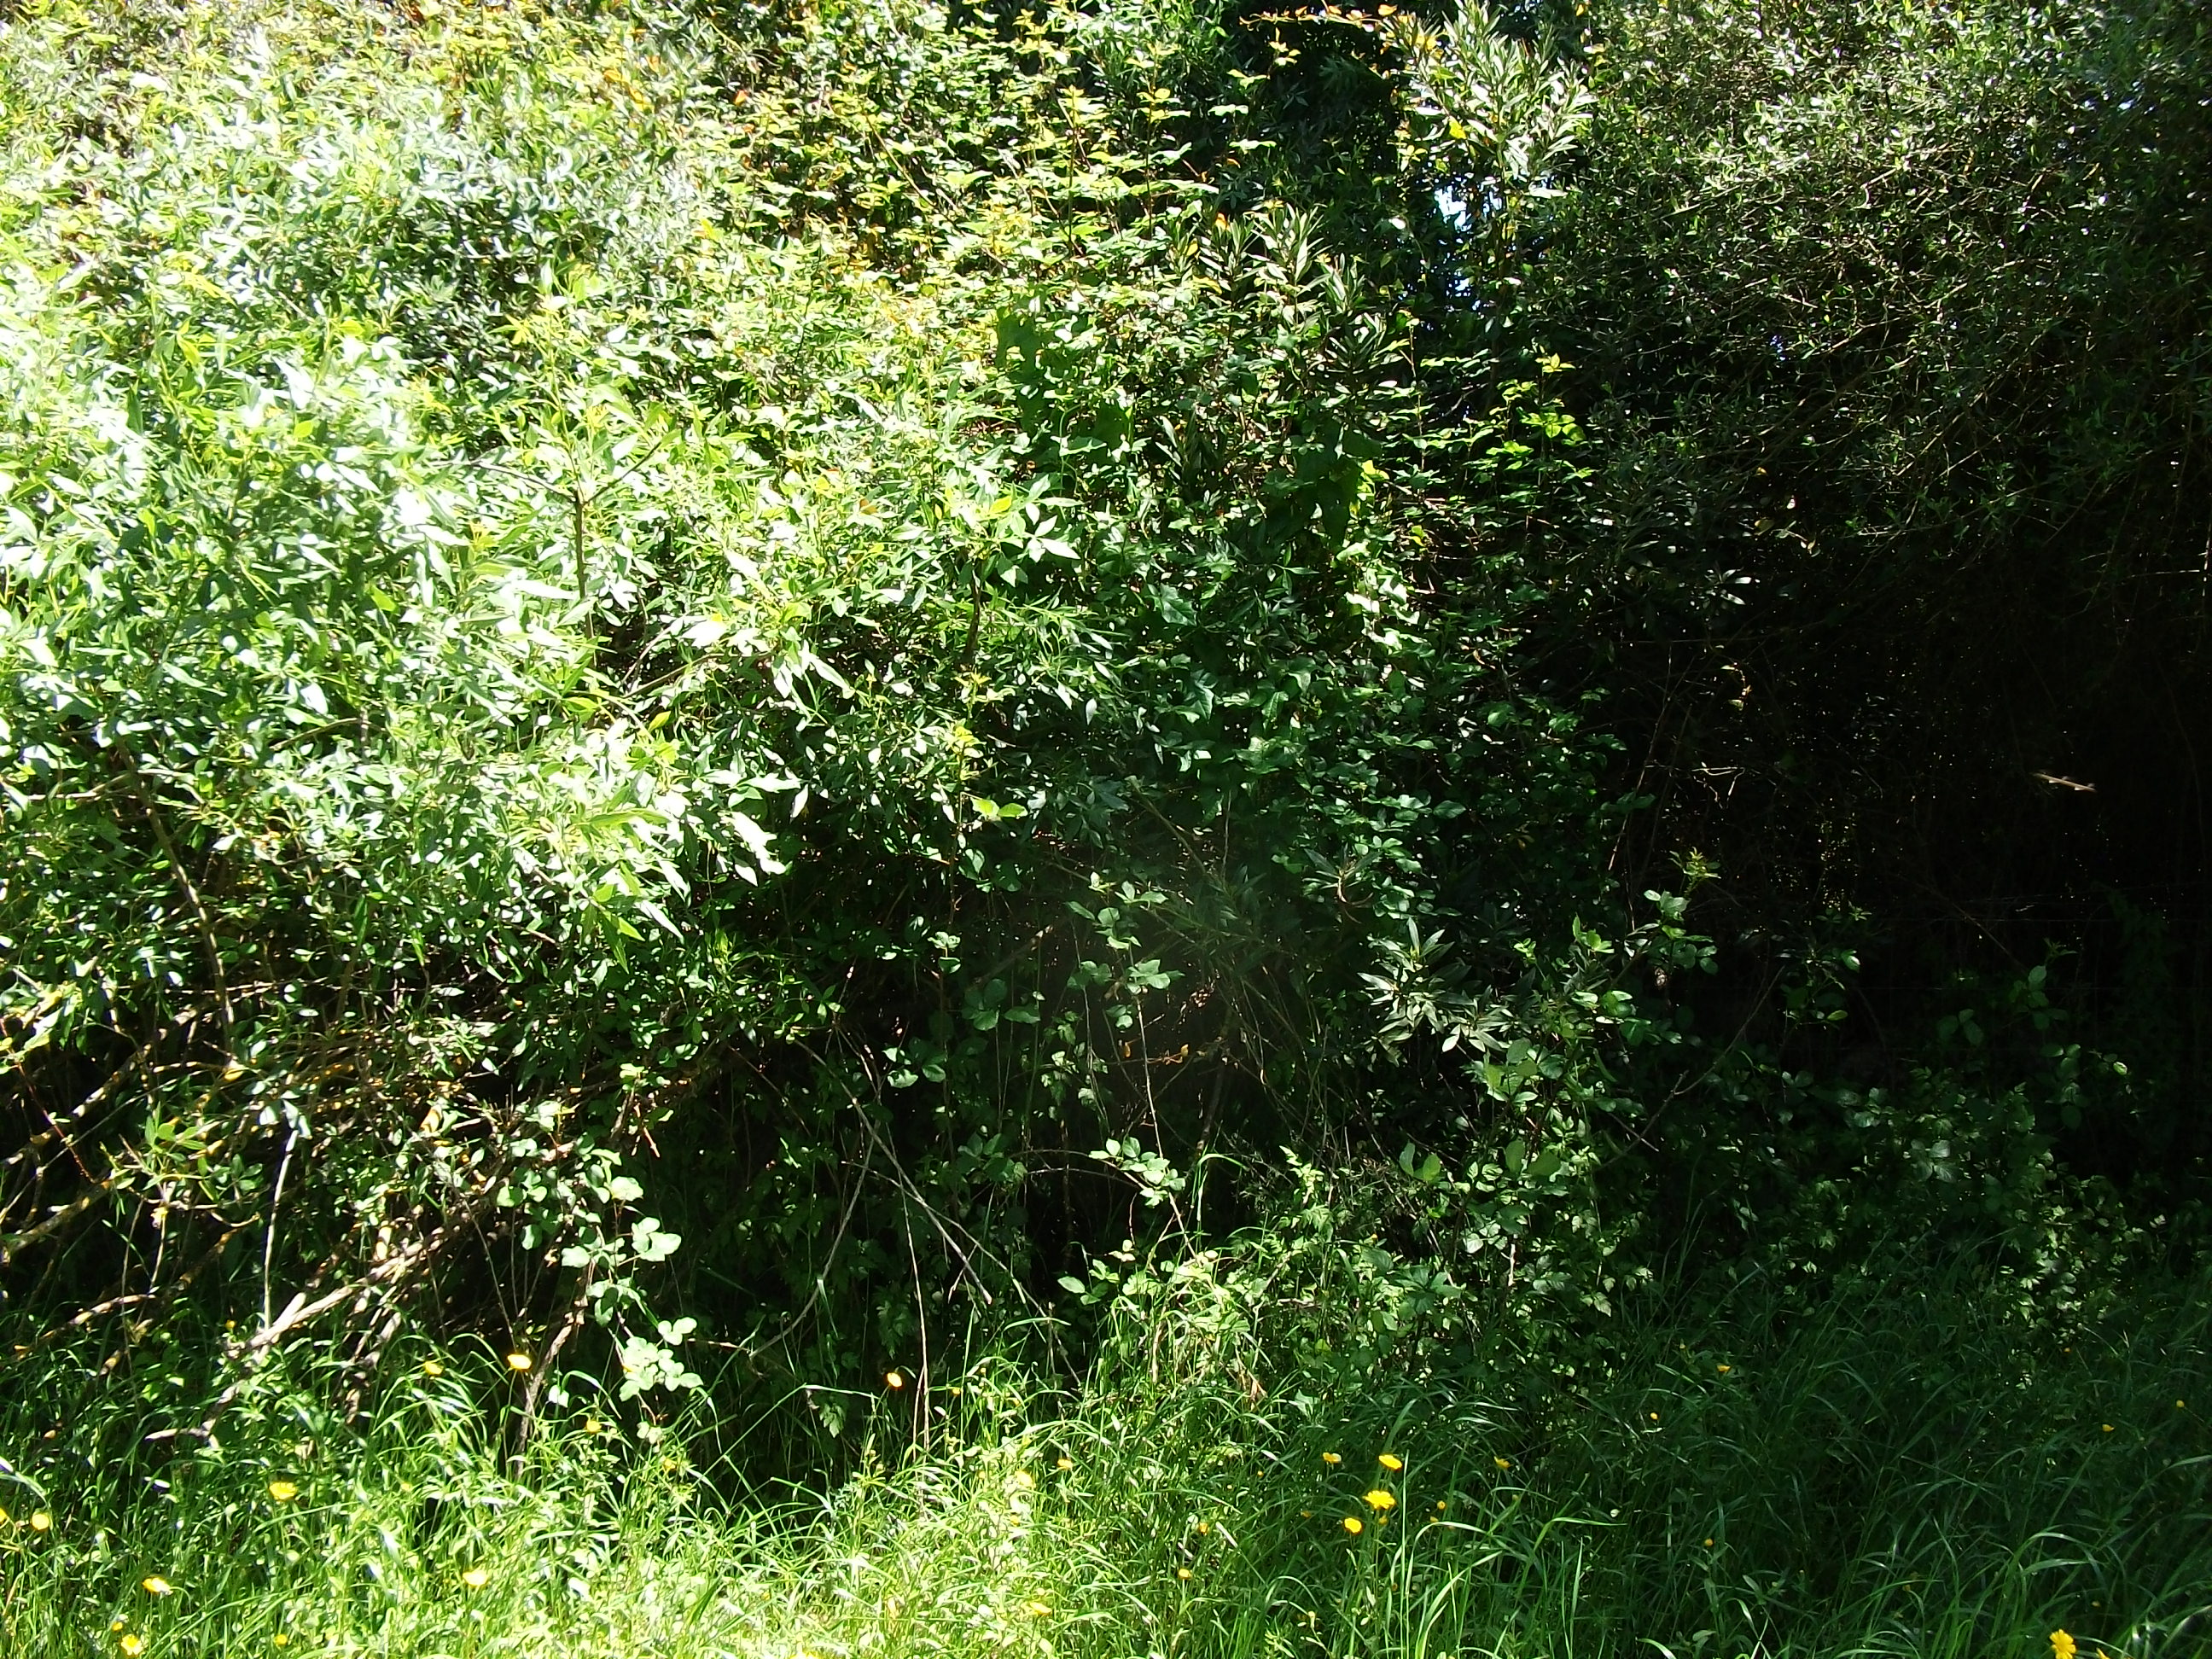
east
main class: Woodland
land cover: Broadleaved woodland
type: broadleaved evergreen forest
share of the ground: 50 - 75 %
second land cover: Spontaneously vegetated surfaces
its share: > 75 %
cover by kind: broadleaved forest trees 70 %, herbaceous plants 30 %
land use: Forestry
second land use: Agriculture (excluding fallow land and kitchen gardens)
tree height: > 5 m
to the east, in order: Broadleaved woodland; Spontaneously vegetated surfaces; Fences; Dry stone walls; Inland fresh running water; Broadleaved woodland; Tracks; Broadleaved woodland
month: April
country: ES
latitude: 37.9690
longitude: -7.0495
